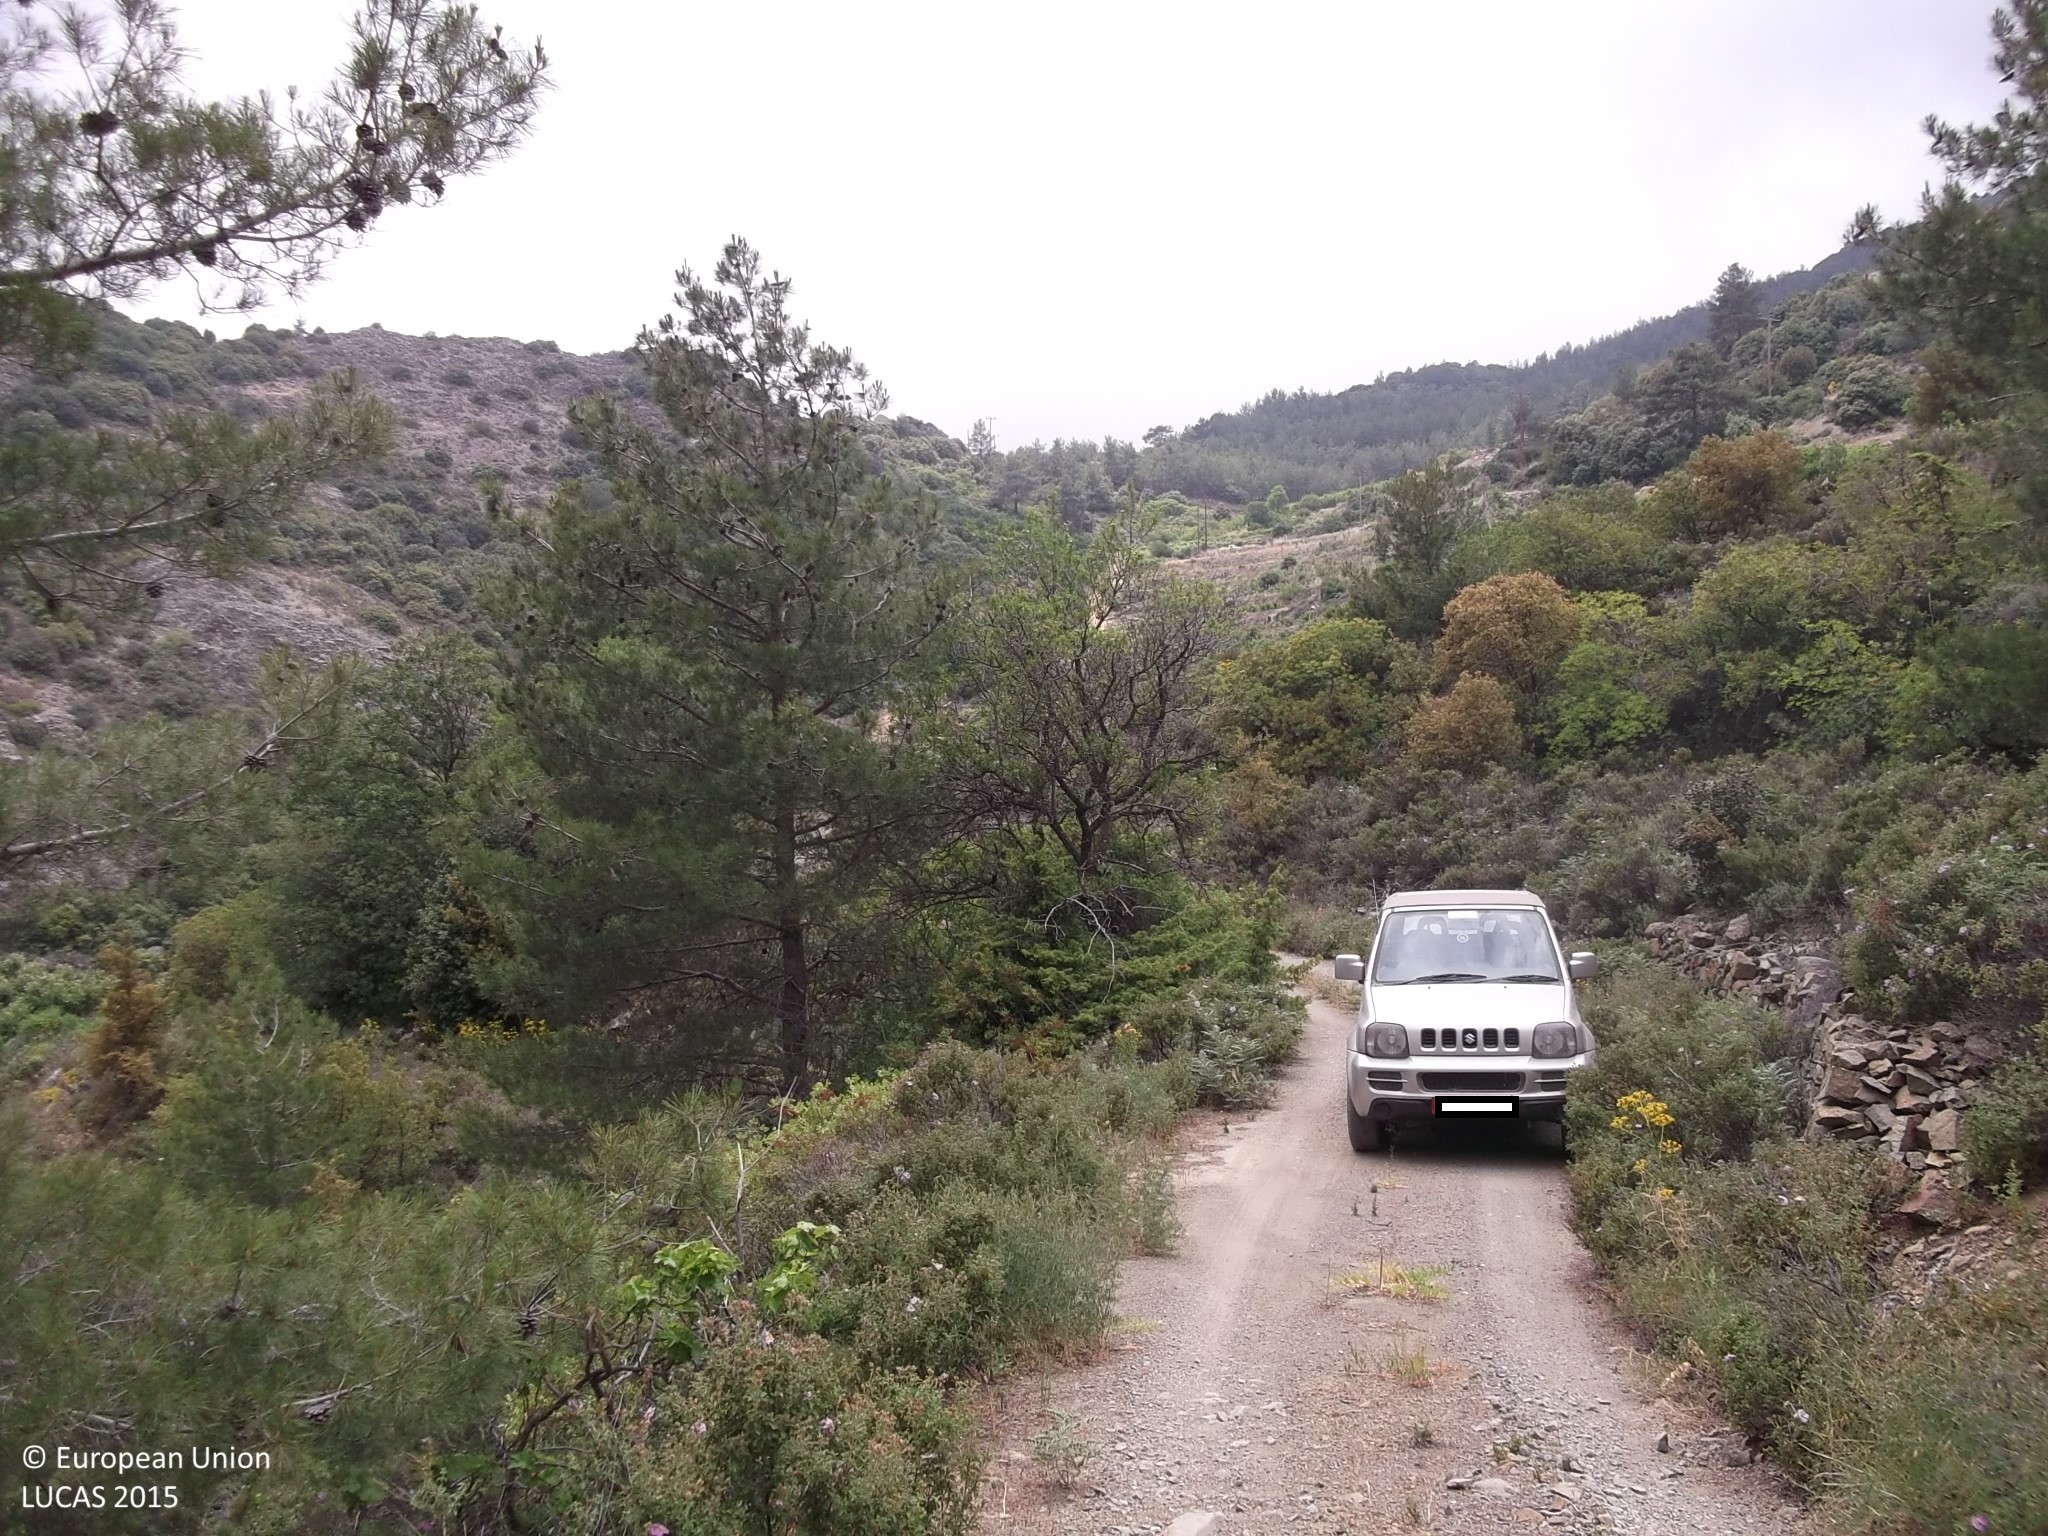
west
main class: Woodland
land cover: Pine dominated mixed woodland
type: coniferous forest of the mediterranean region
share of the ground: 25 - 50 %
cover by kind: coniferous forest trees 40 %, shrubs 35 %, broadleaved forest trees 15 %, unconsolidated bare surface 10 %
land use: Semi-natural and natural areas not in use
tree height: > 5 m
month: June
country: CY
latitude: 34.9490
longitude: 32.9802
